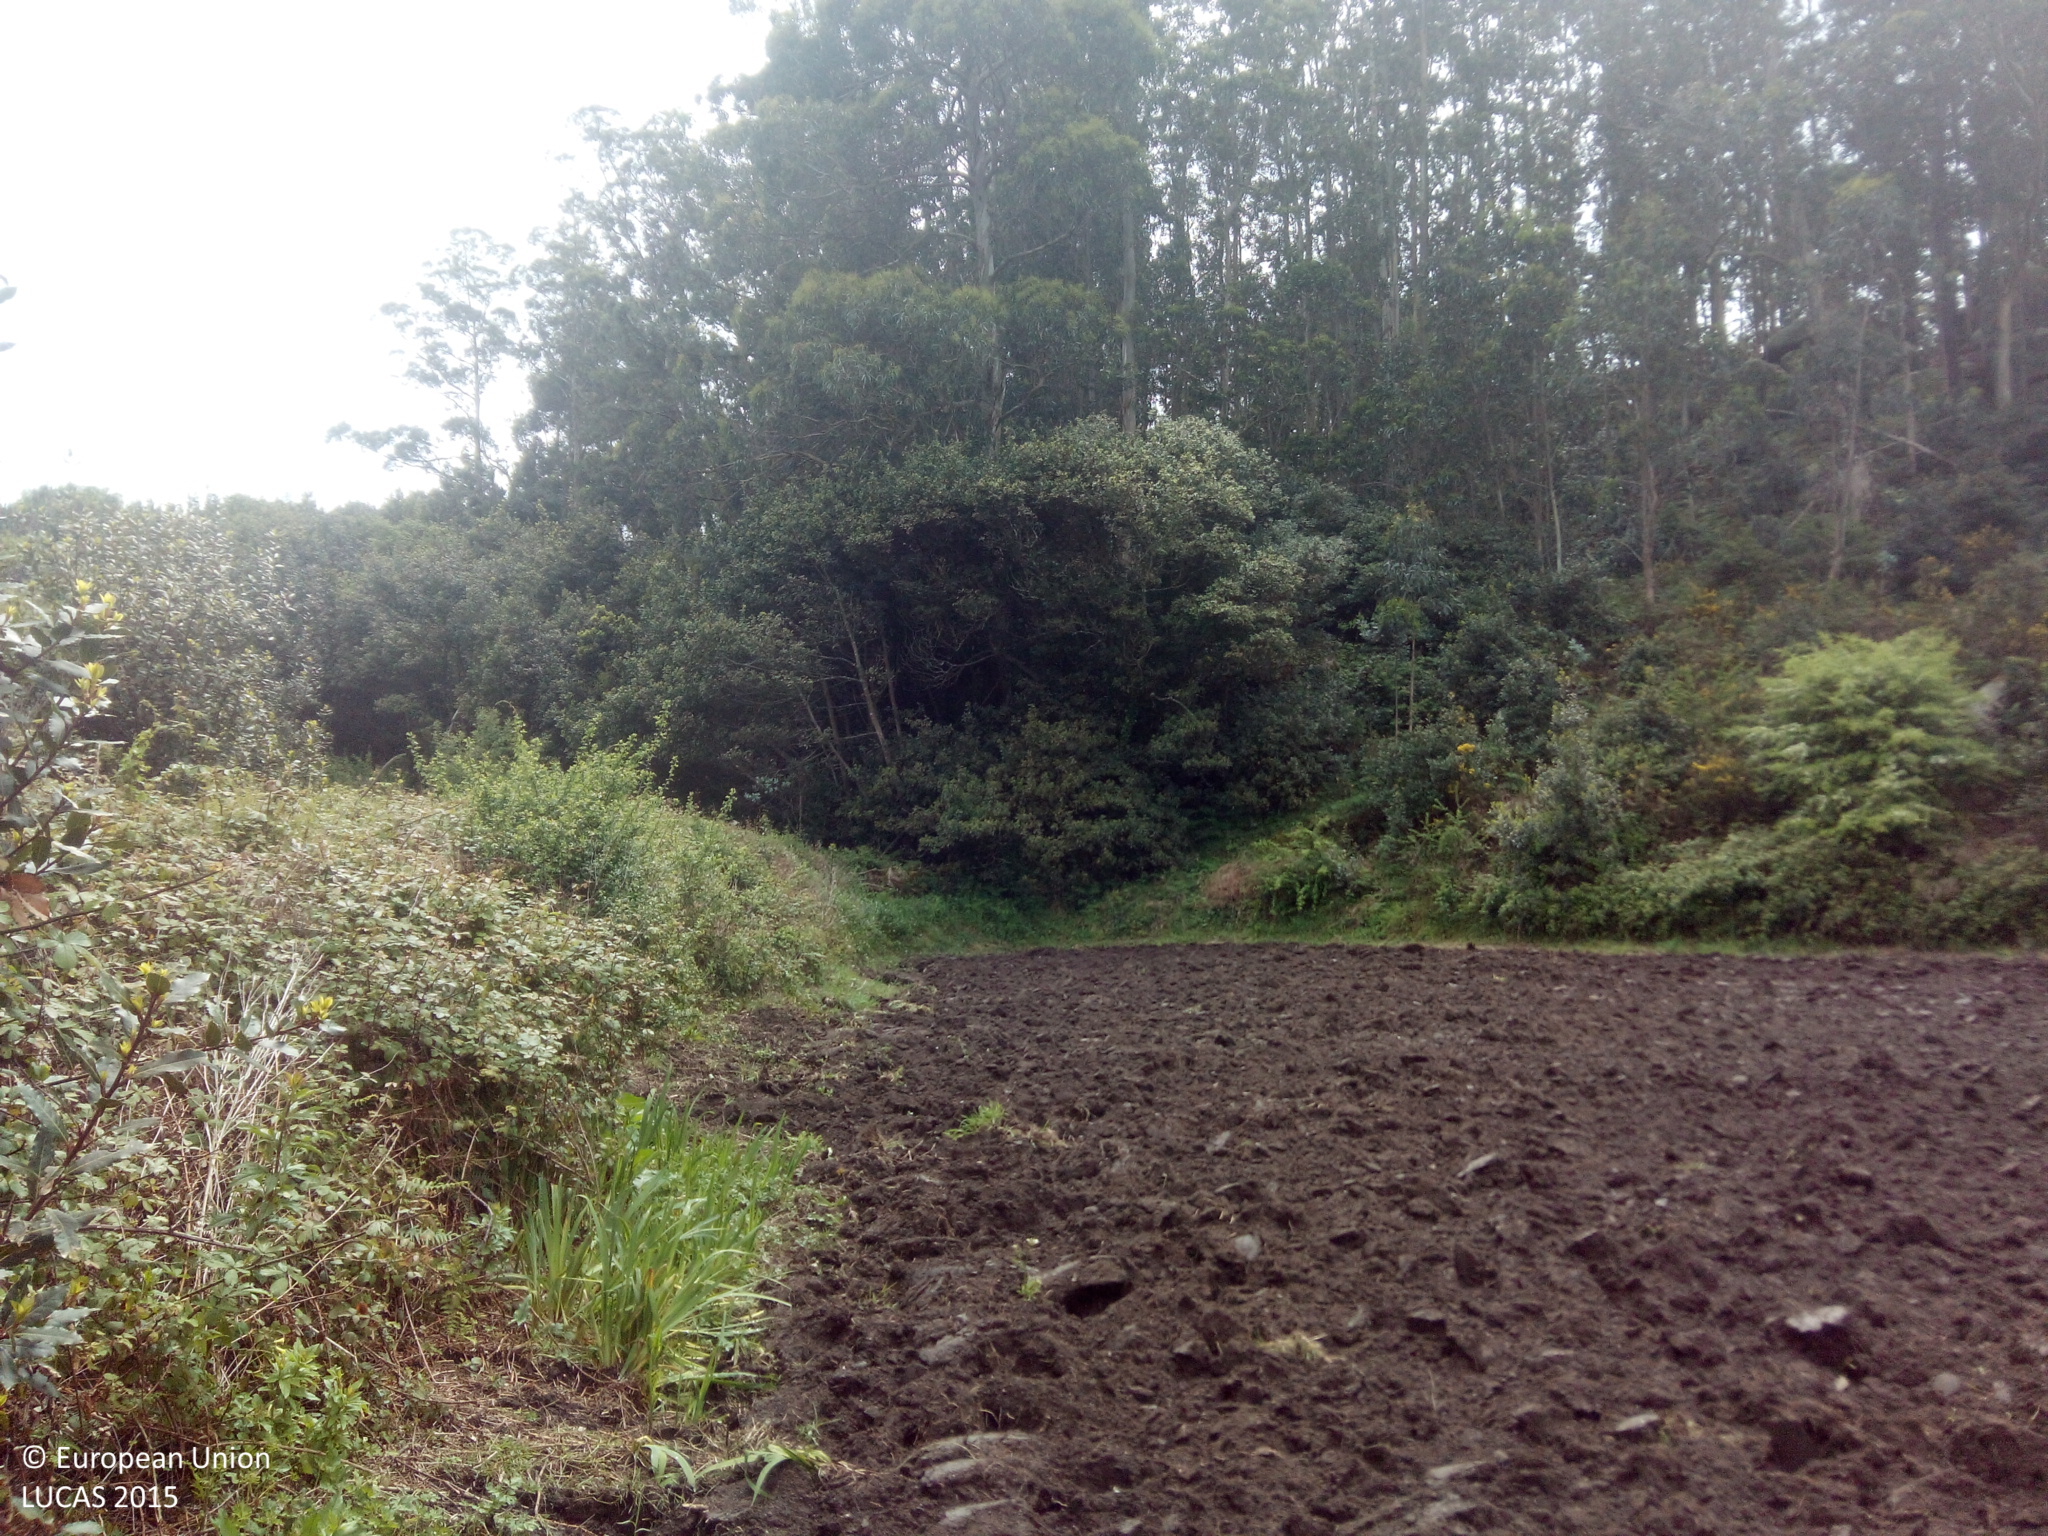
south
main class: Shrubland
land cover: Shrubland with sparse tree cover
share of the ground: > 75 %
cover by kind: shrubs 95 %, broadleaved forest trees 5 %
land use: Abandoned areas
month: April
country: ES
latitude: 42.4774
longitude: -8.9294
